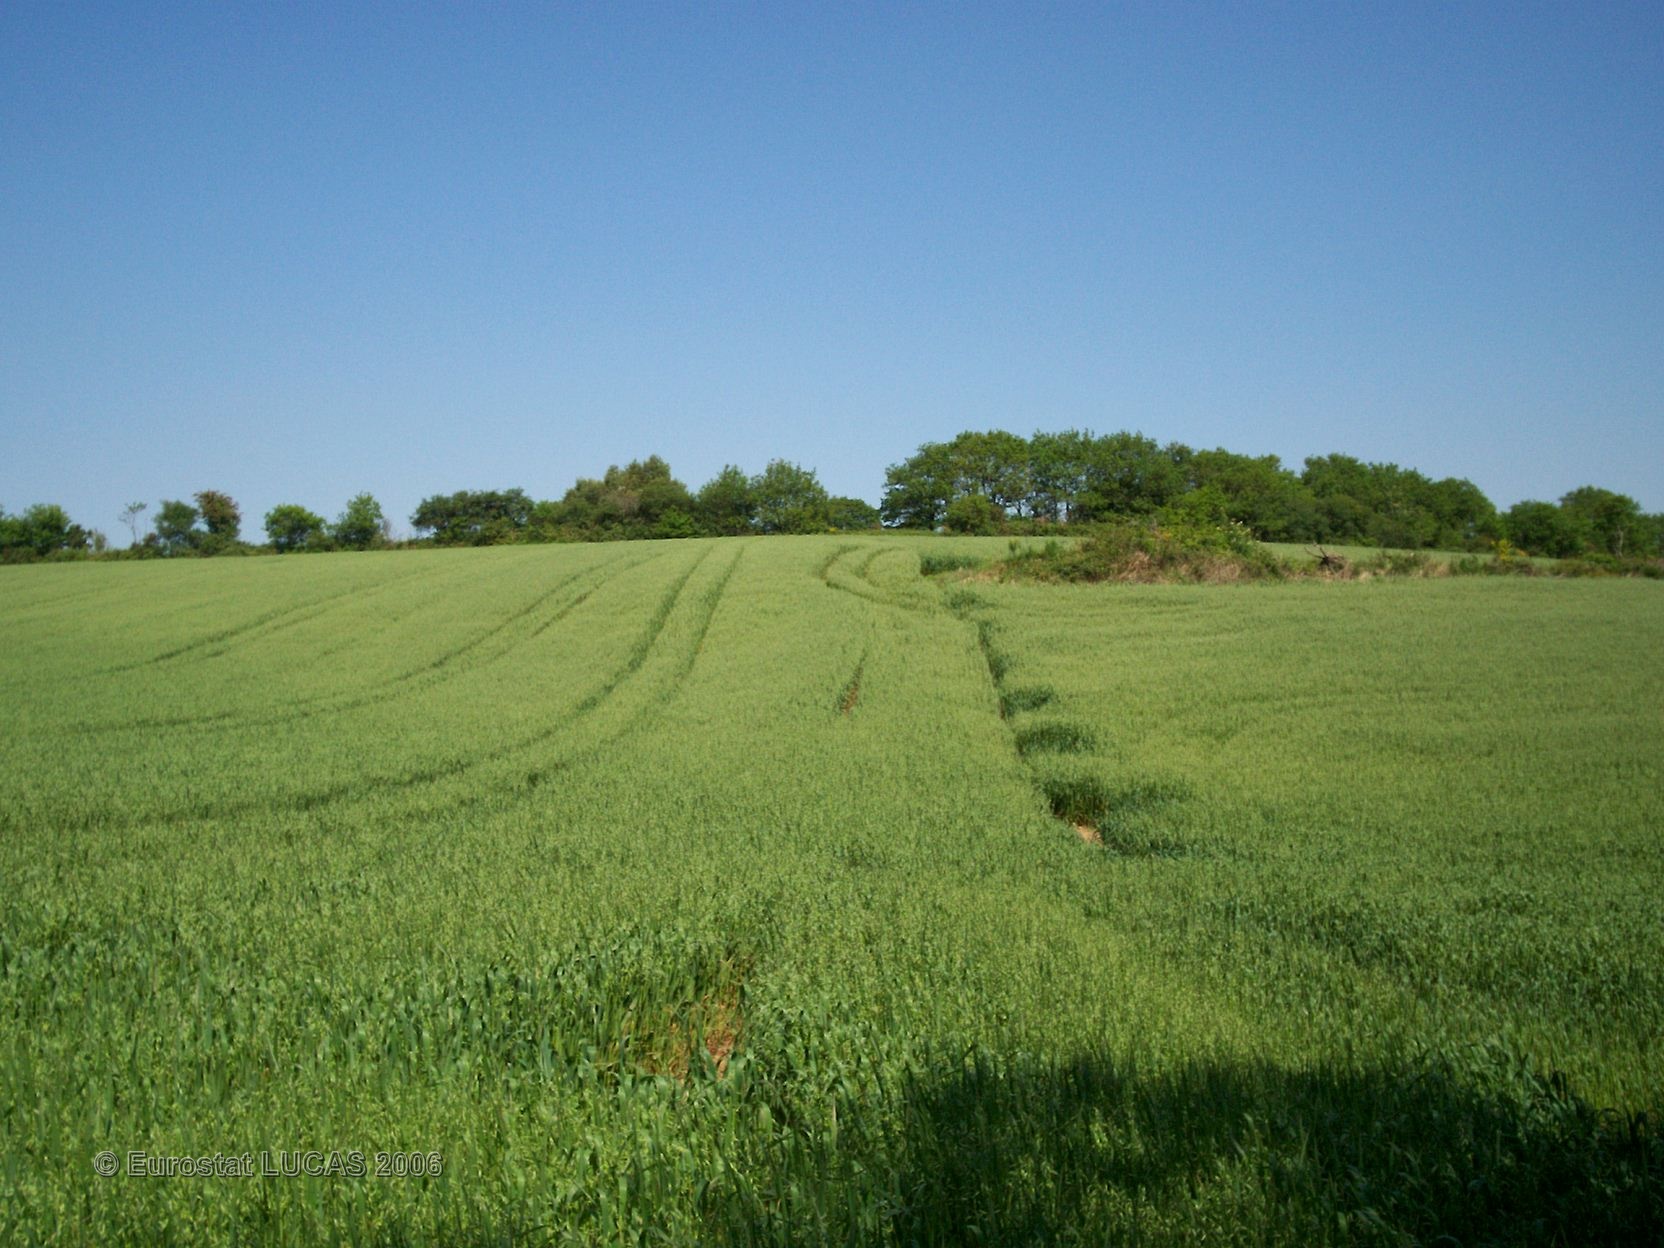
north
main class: Cropland
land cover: Oats
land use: Agriculture (excluding fallow land and kitchen gardens)
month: June
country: FR
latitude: 48.2944
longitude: -3.9846
